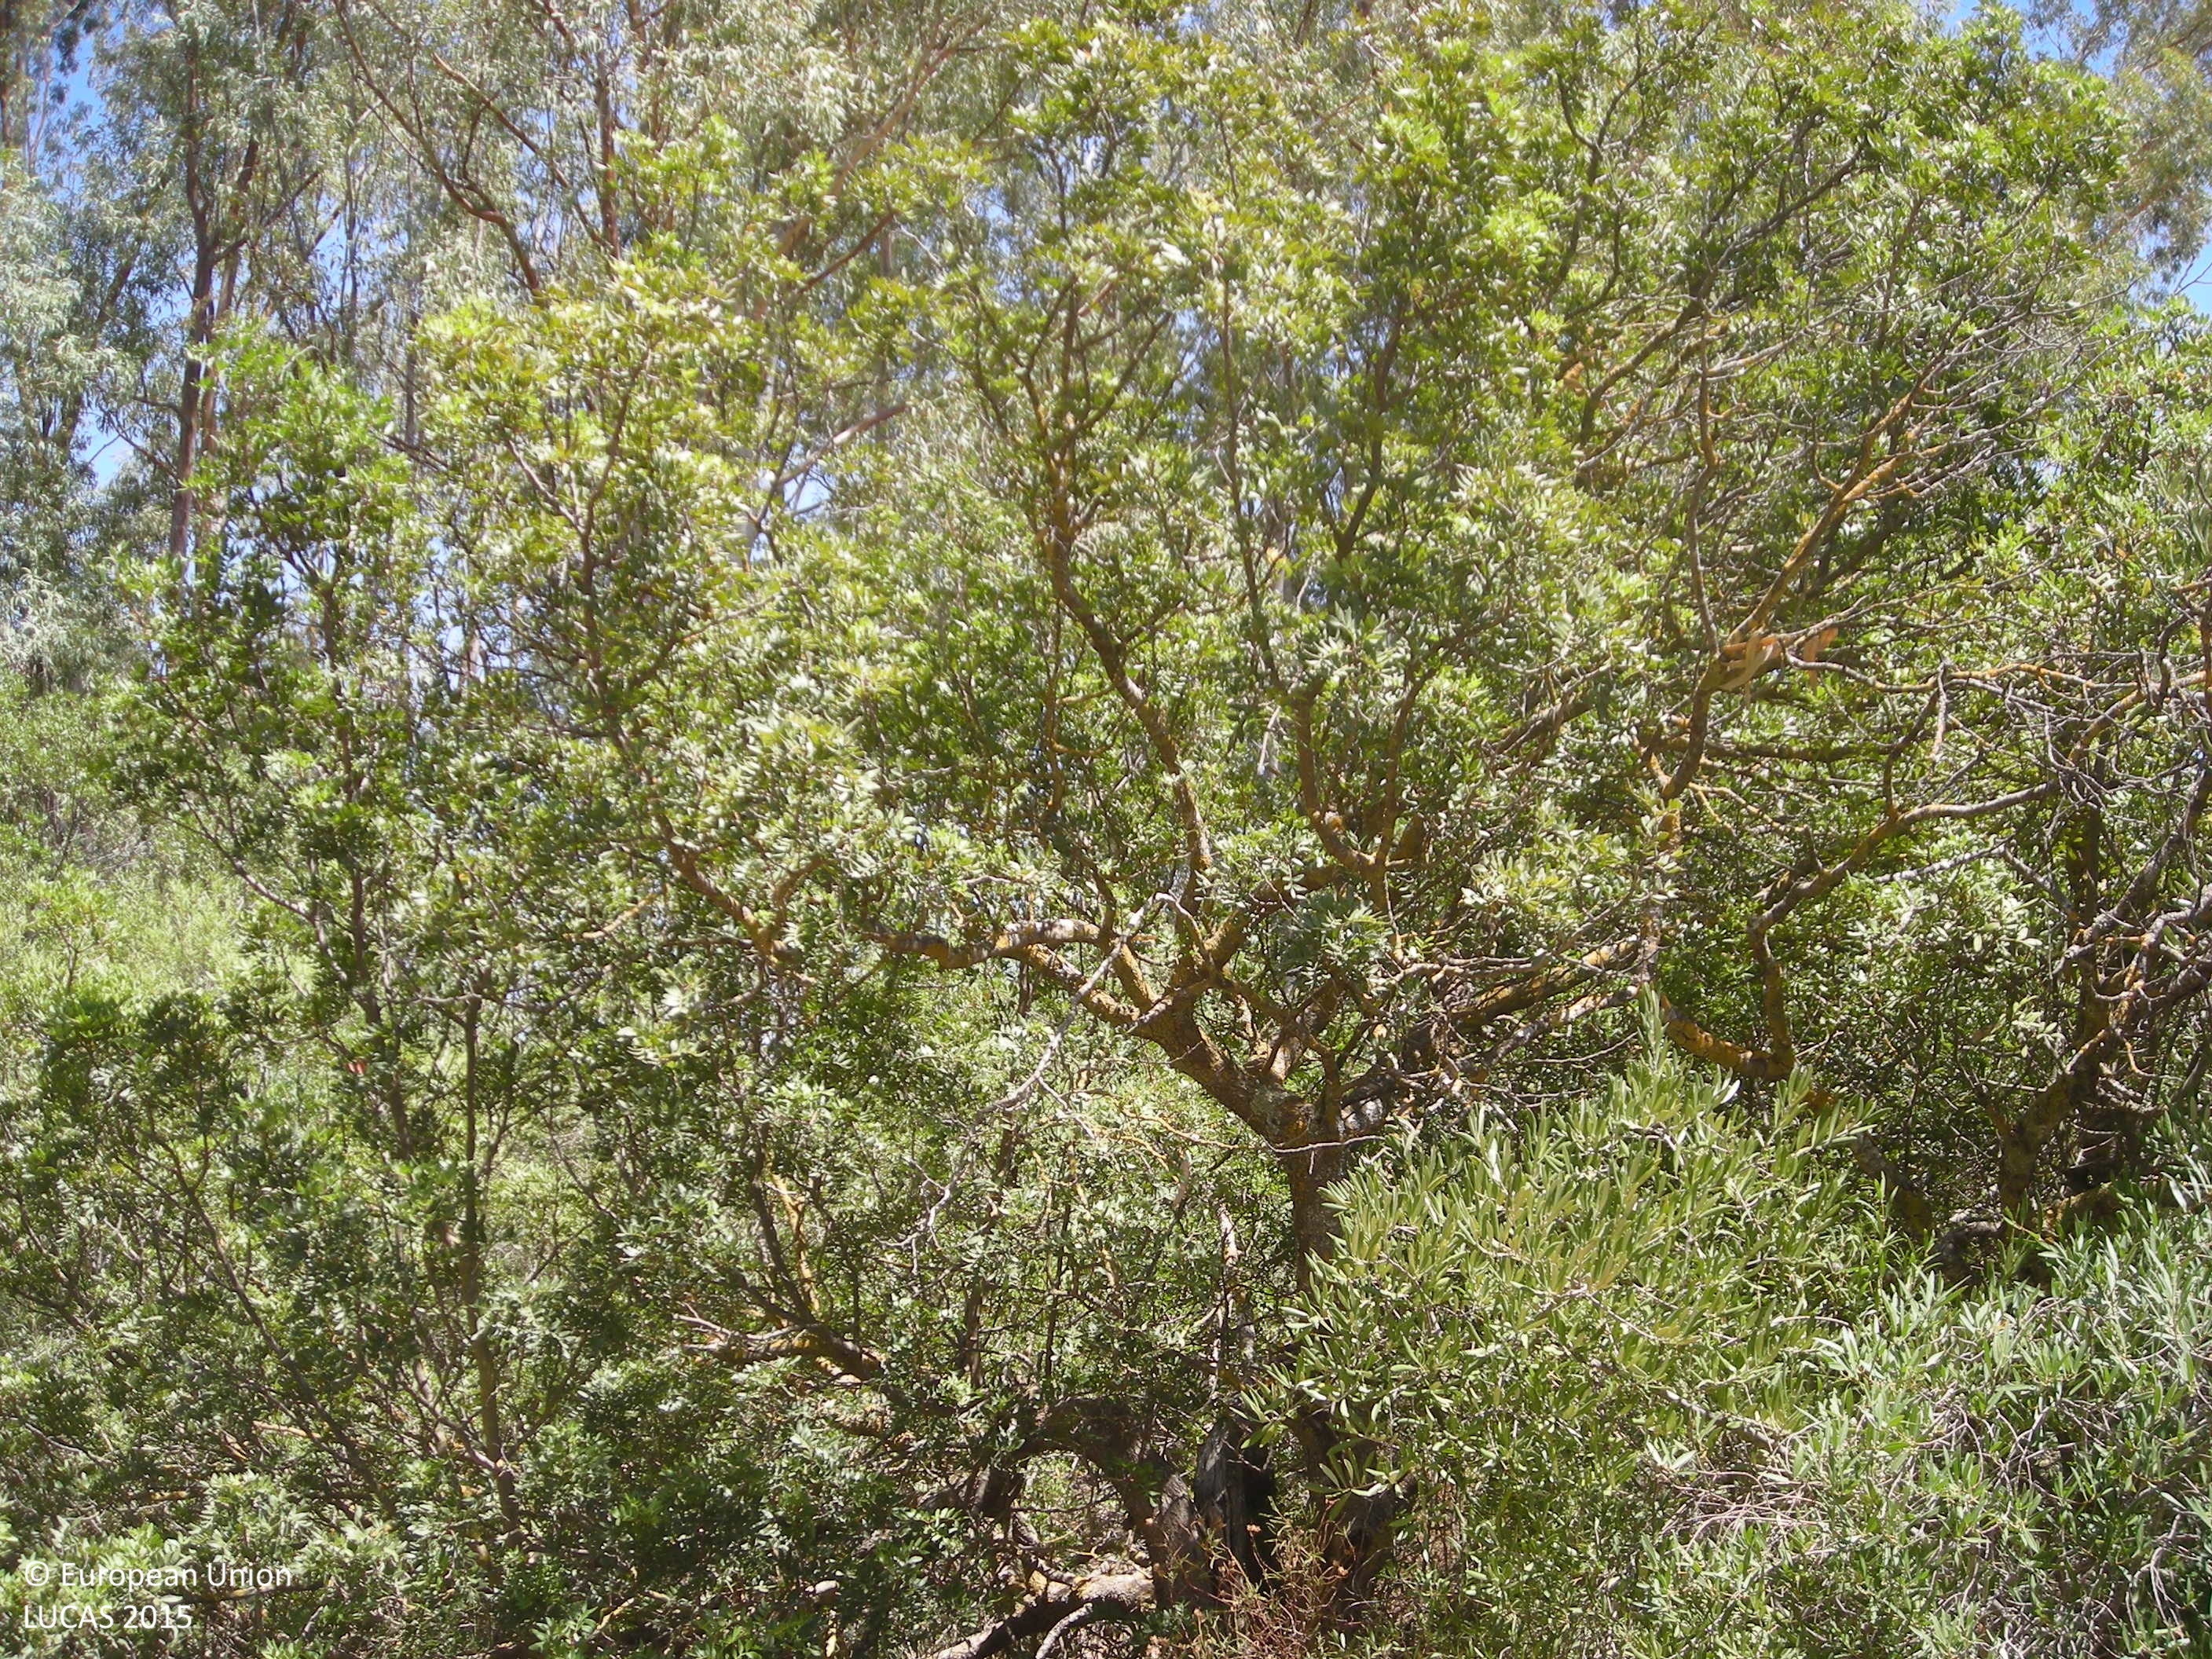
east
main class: Shrubland
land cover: Shrubland without tree cover
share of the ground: > 75 %
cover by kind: shrubs 100 %
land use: Semi-natural and natural areas not in use
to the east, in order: Shrubland without tree cover
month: July
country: ES
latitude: 38.7574
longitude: -5.7986
